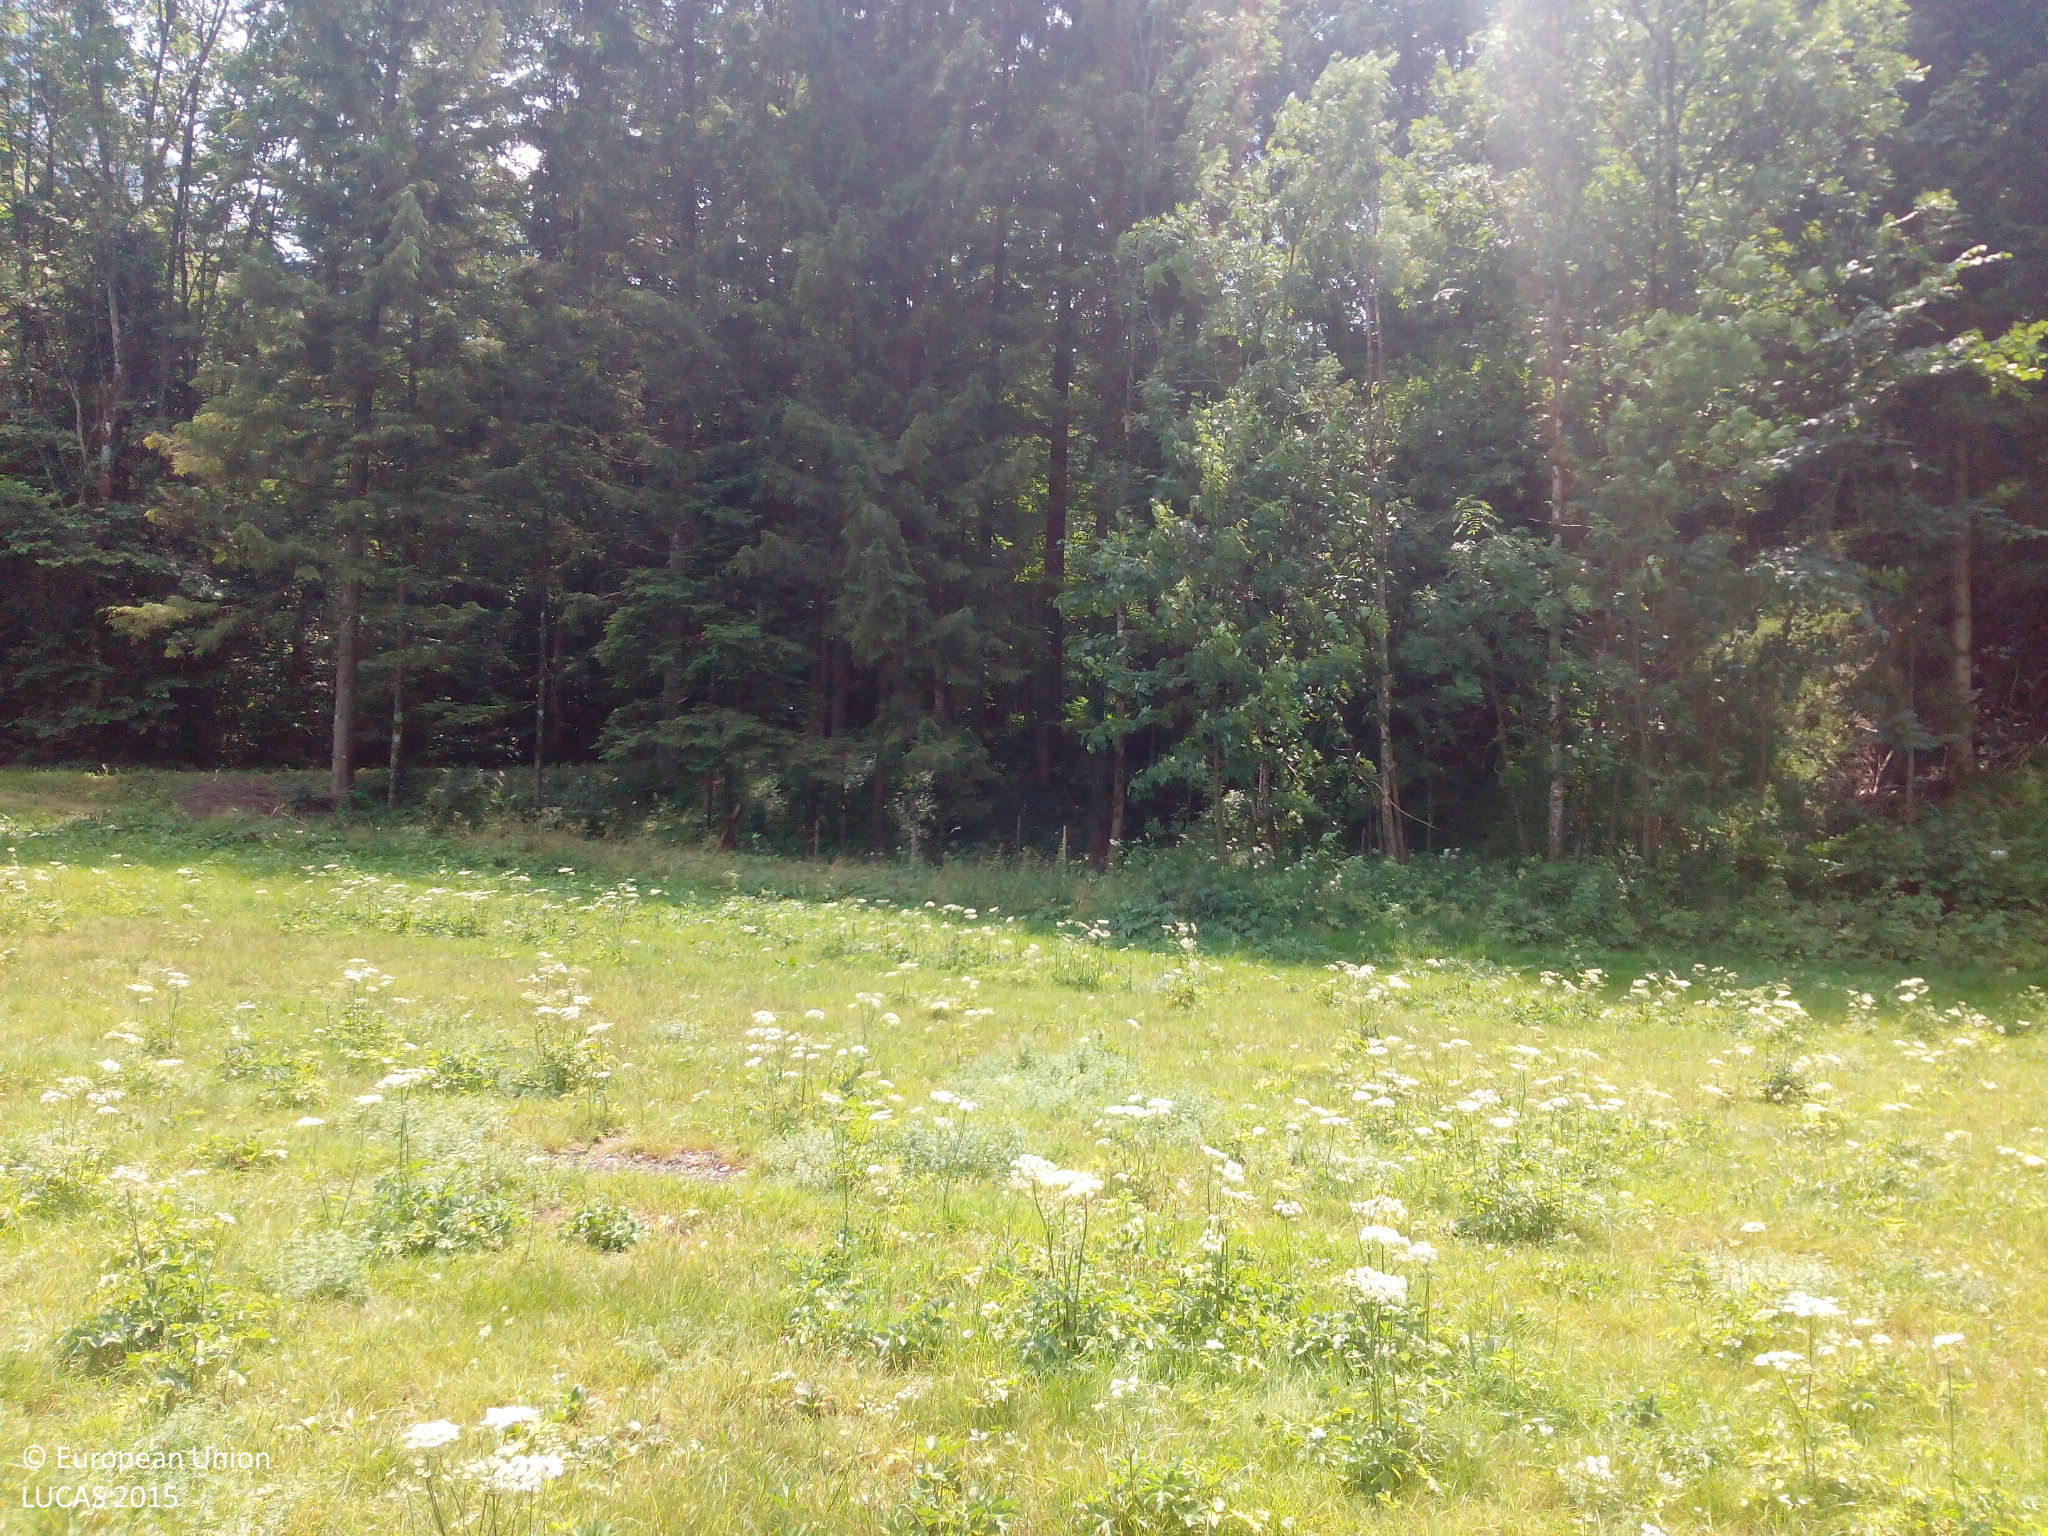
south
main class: Grassland
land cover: Grassland without tree/shrub cover
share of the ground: > 75 %
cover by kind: herbaceous plants 100 %
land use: Agriculture (excluding fallow land and kitchen gardens)
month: July
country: DE
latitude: 47.7493
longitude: 12.3061
